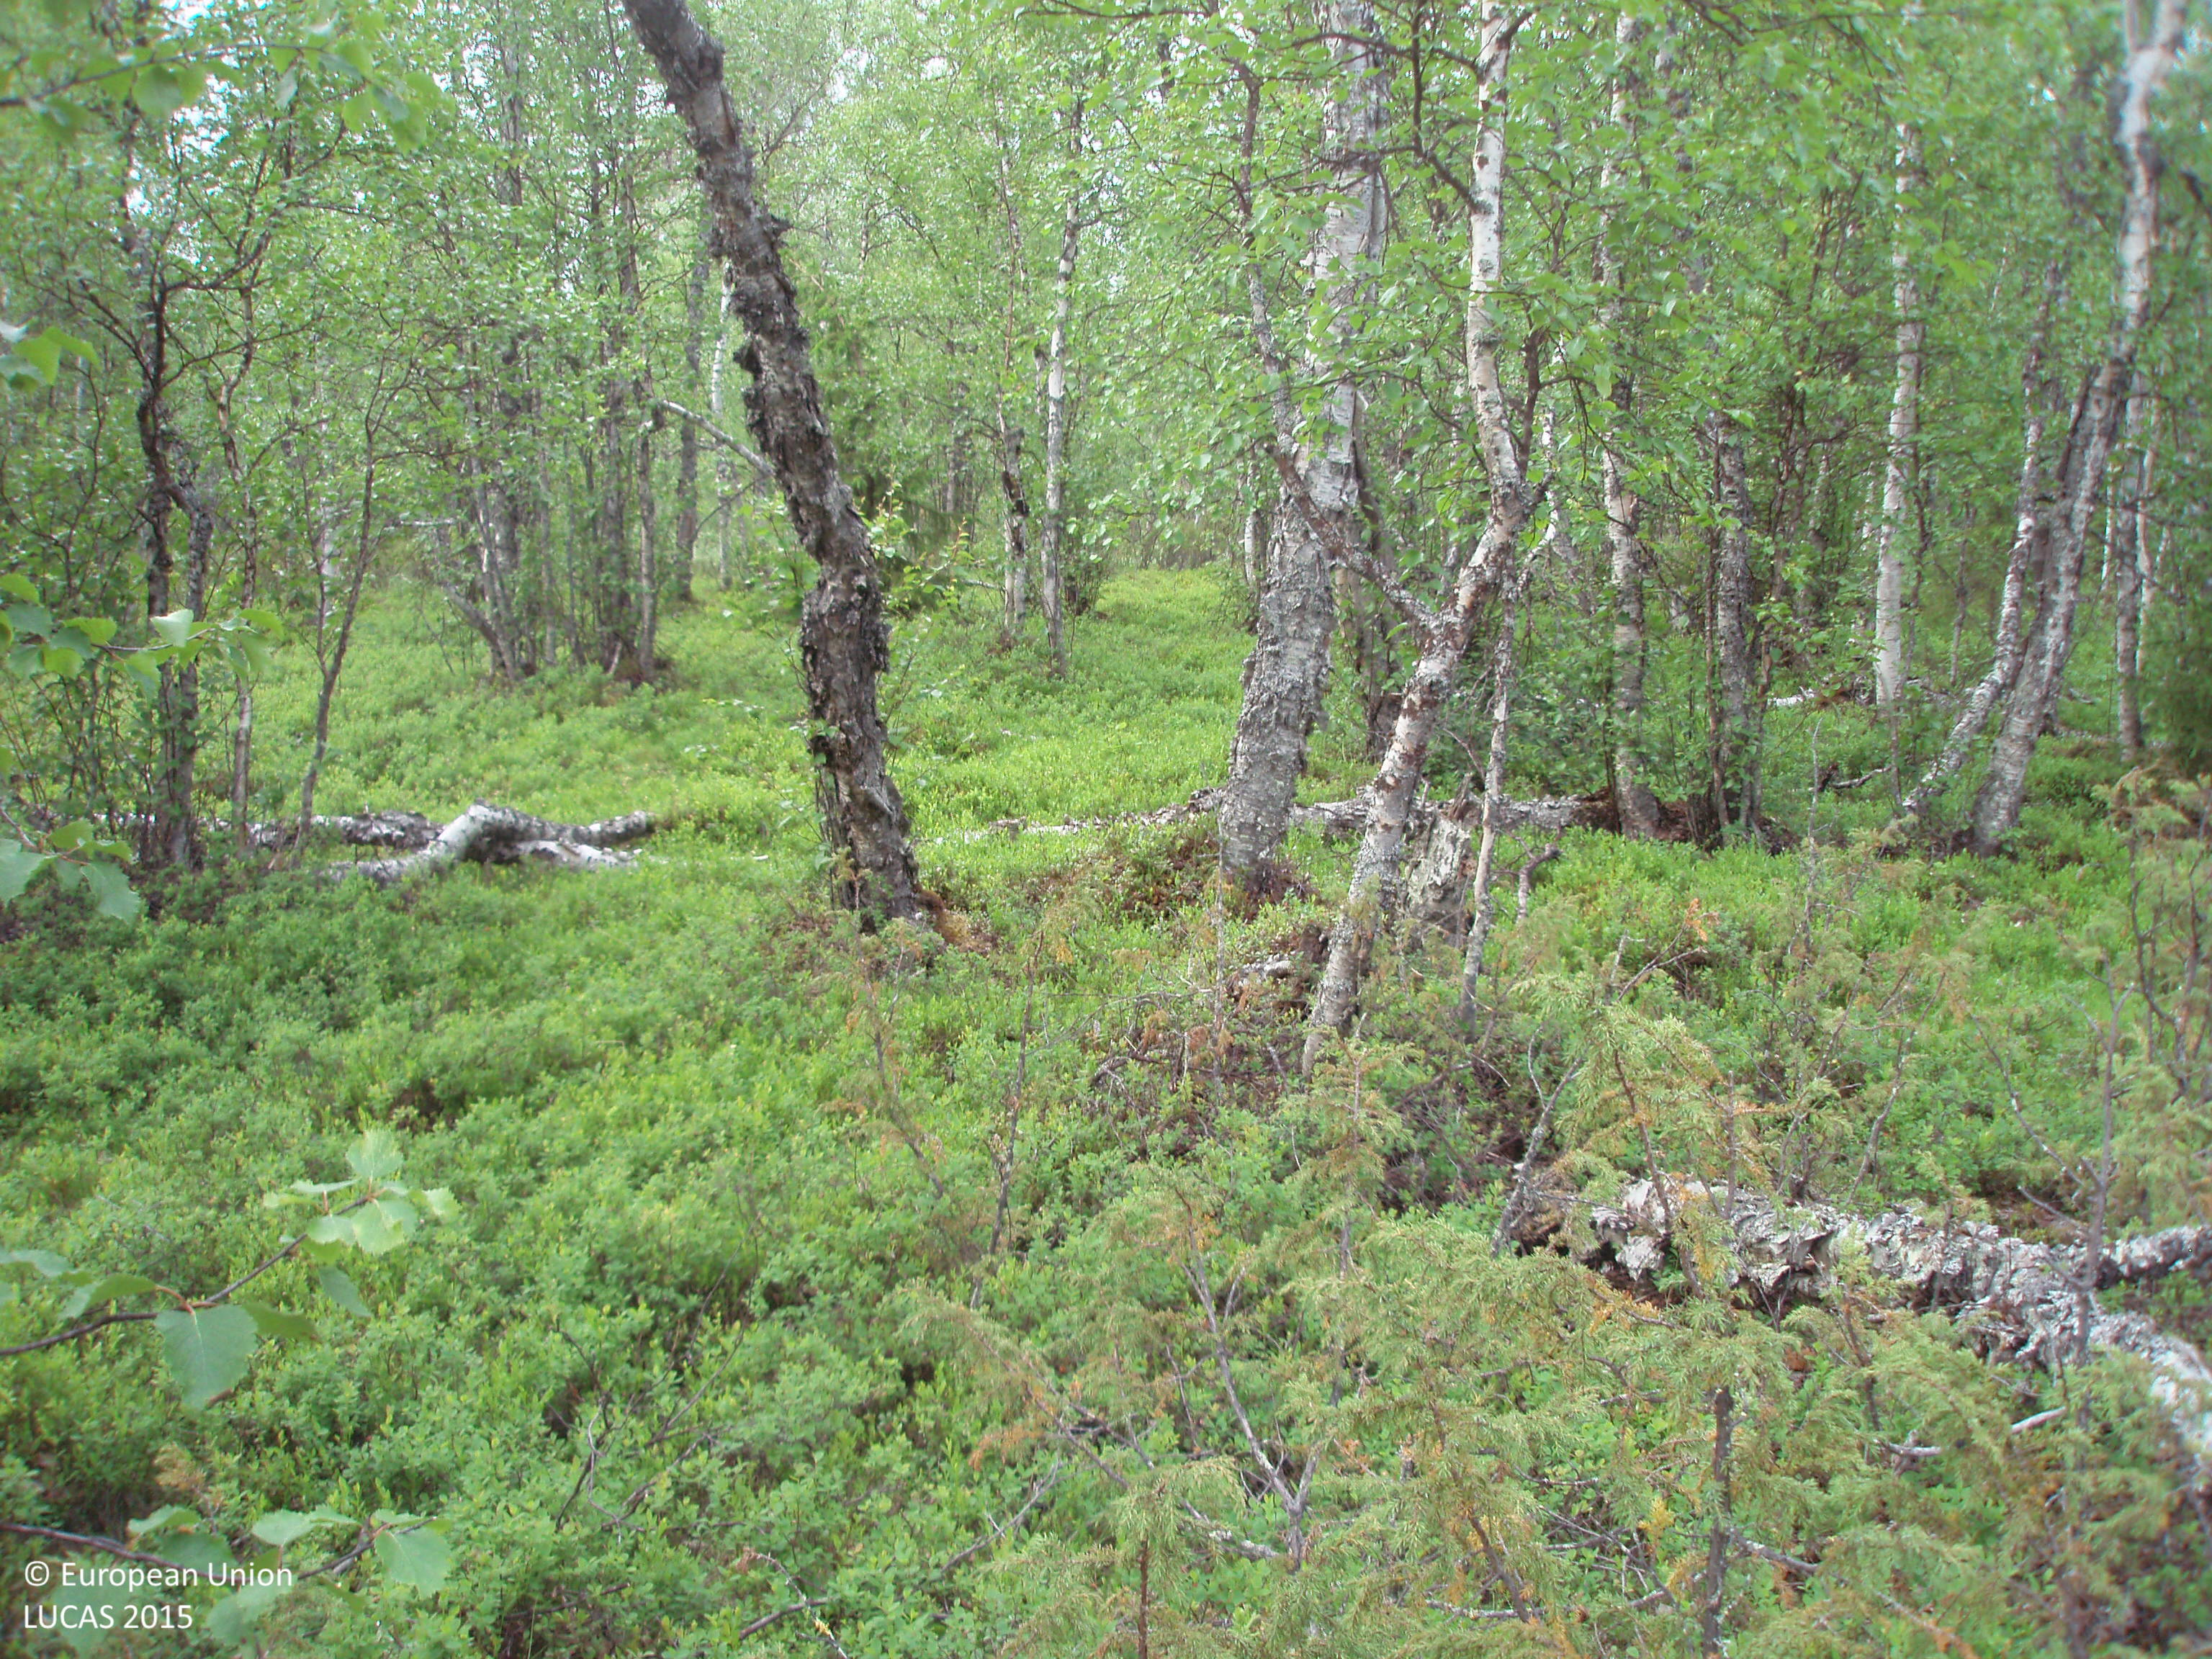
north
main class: Woodland
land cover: Broadleaved woodland
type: non-riverine alder, birch or aspen forest
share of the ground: > 75 %
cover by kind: broadleaved forest trees 70 %, shrubs 25 %, coniferous forest trees 5 %
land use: Forestry
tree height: > 5 m
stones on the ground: 10 - 25 %
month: July
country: FI
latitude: 67.8291
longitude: 29.1658
